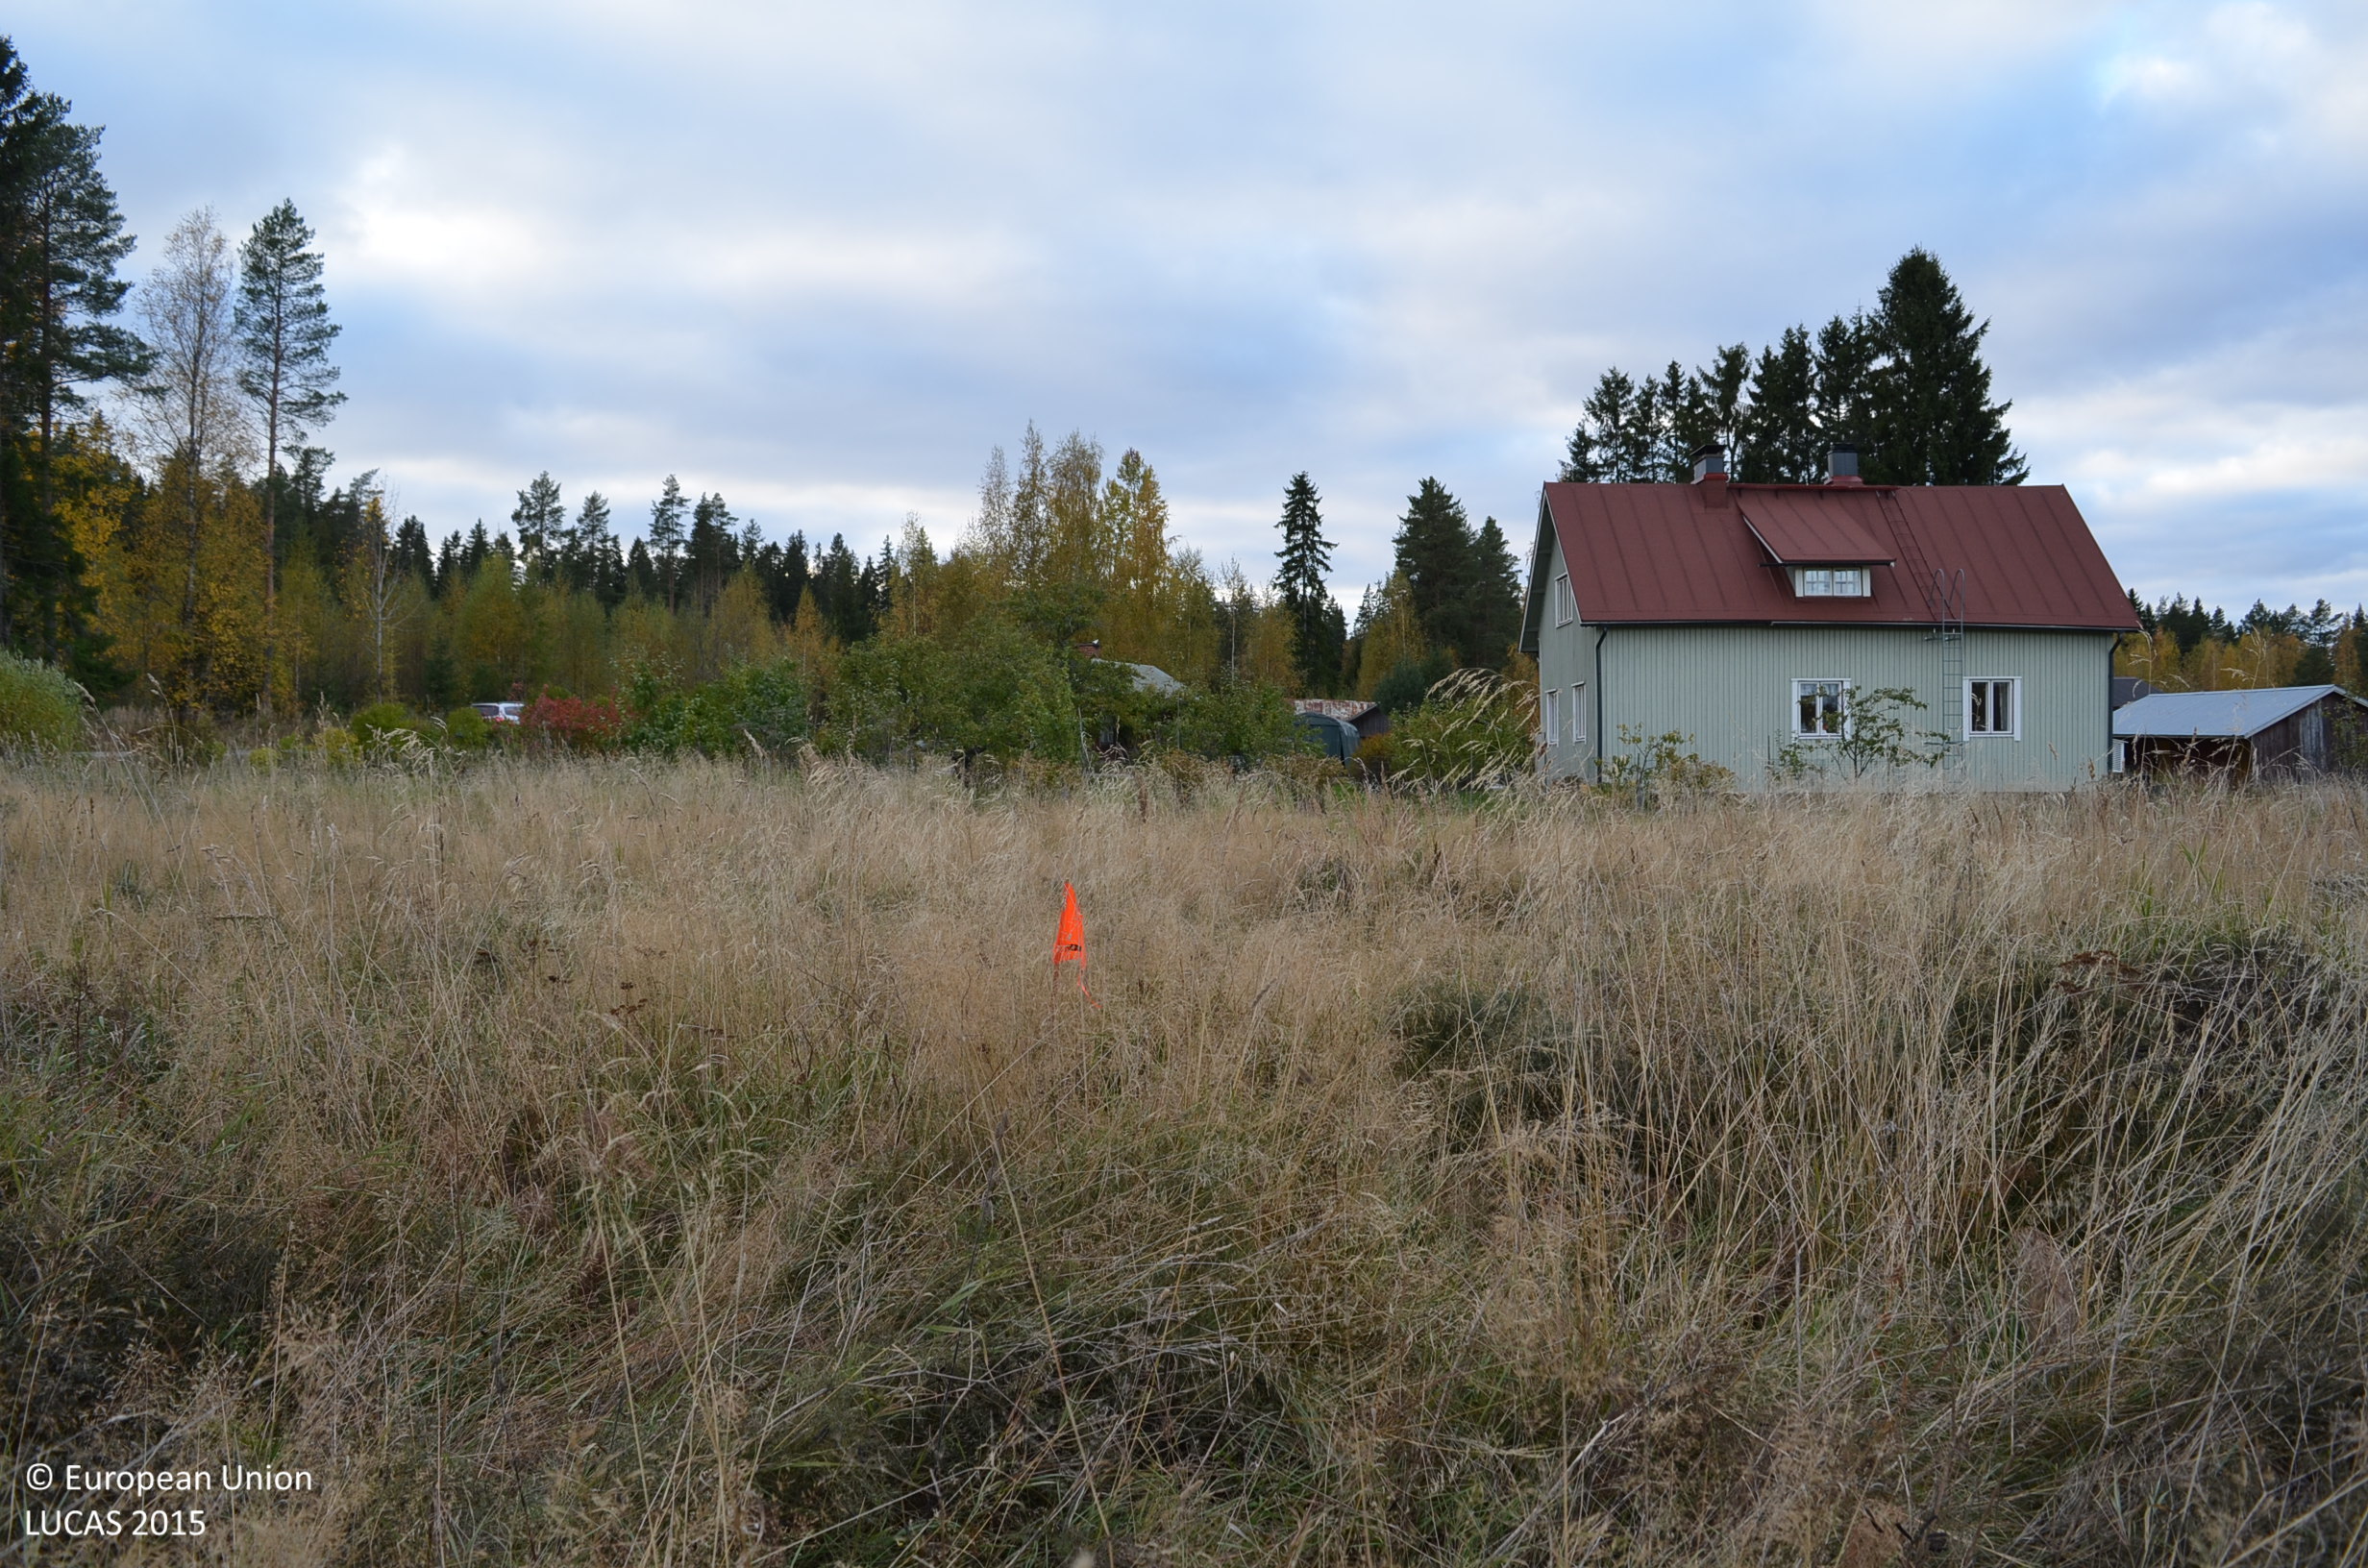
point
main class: Grassland
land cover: Grassland without tree/shrub cover
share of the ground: > 75 %
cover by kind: herbaceous plants 100 %
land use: Abandoned areas
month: October
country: FI
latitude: 61.6245
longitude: 23.7965
